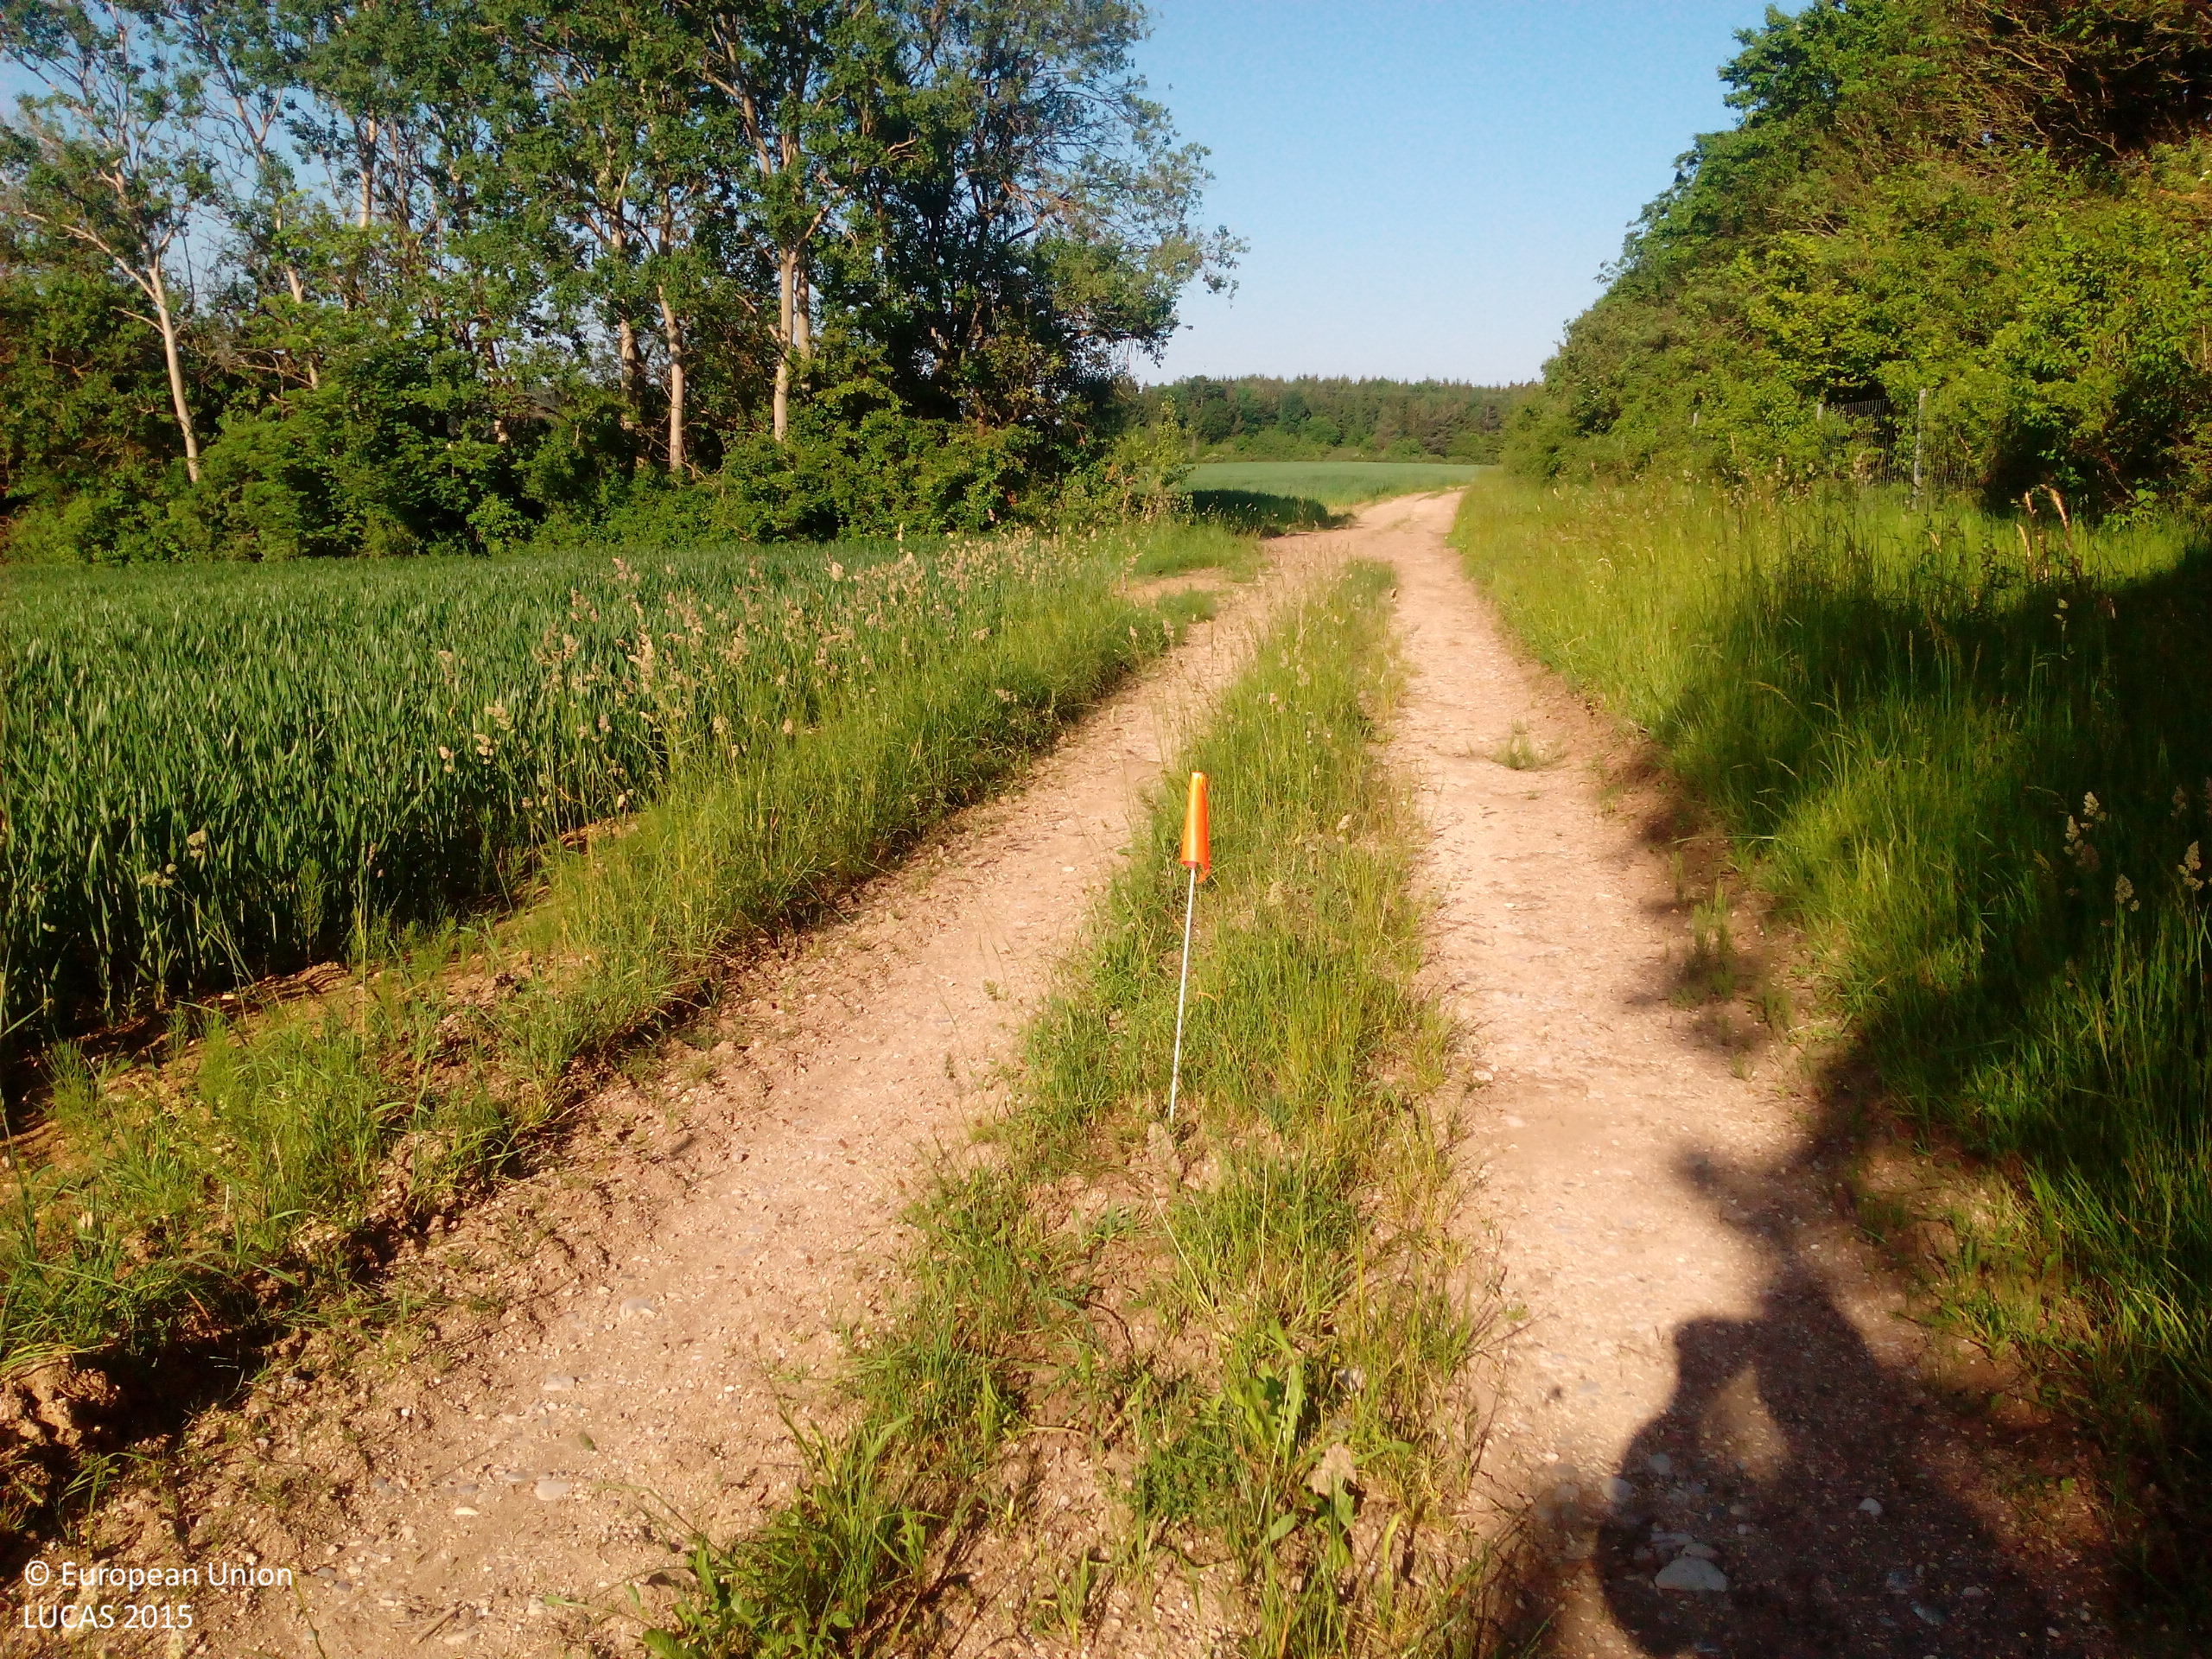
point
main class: Cropland
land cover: Common wheat
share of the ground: > 75 %
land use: Agriculture (excluding fallow land and kitchen gardens)
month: June
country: DE
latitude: 47.8926
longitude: 8.7570
